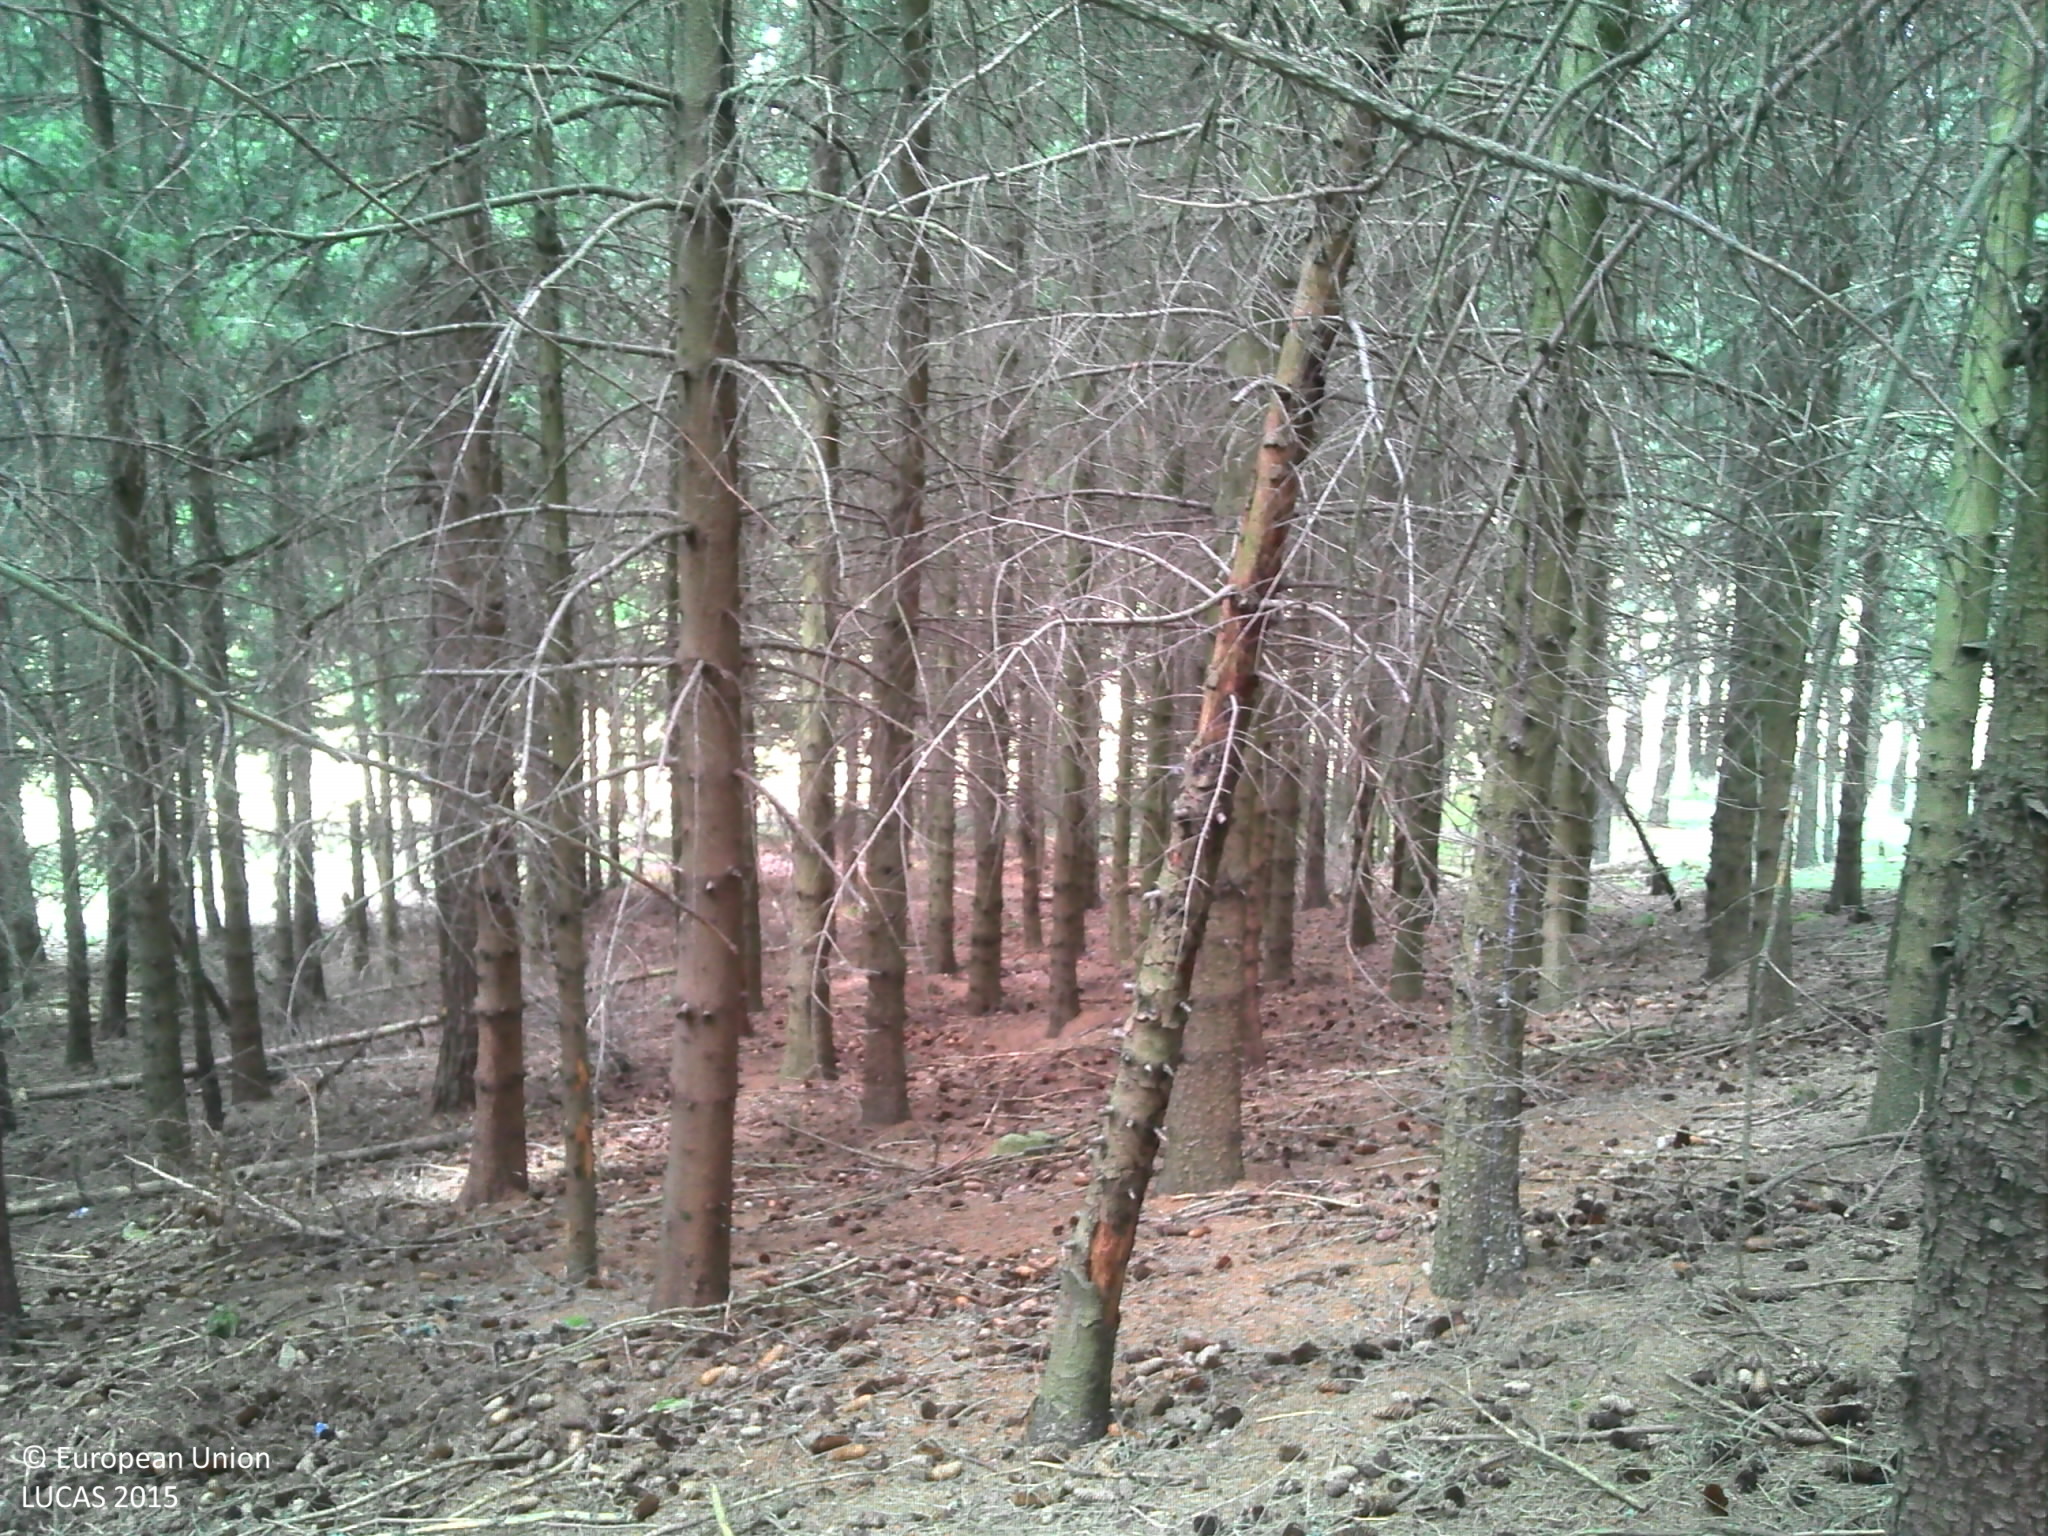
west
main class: Woodland
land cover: Spruce dominated coniferous woodland
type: alpine coniferous forest
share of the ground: > 75 %
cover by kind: coniferous forest trees 90 %, unconsolidated bare surface 10 %
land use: Forestry
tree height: > 5 m
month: September
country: FR
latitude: 44.8970
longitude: 4.2688
